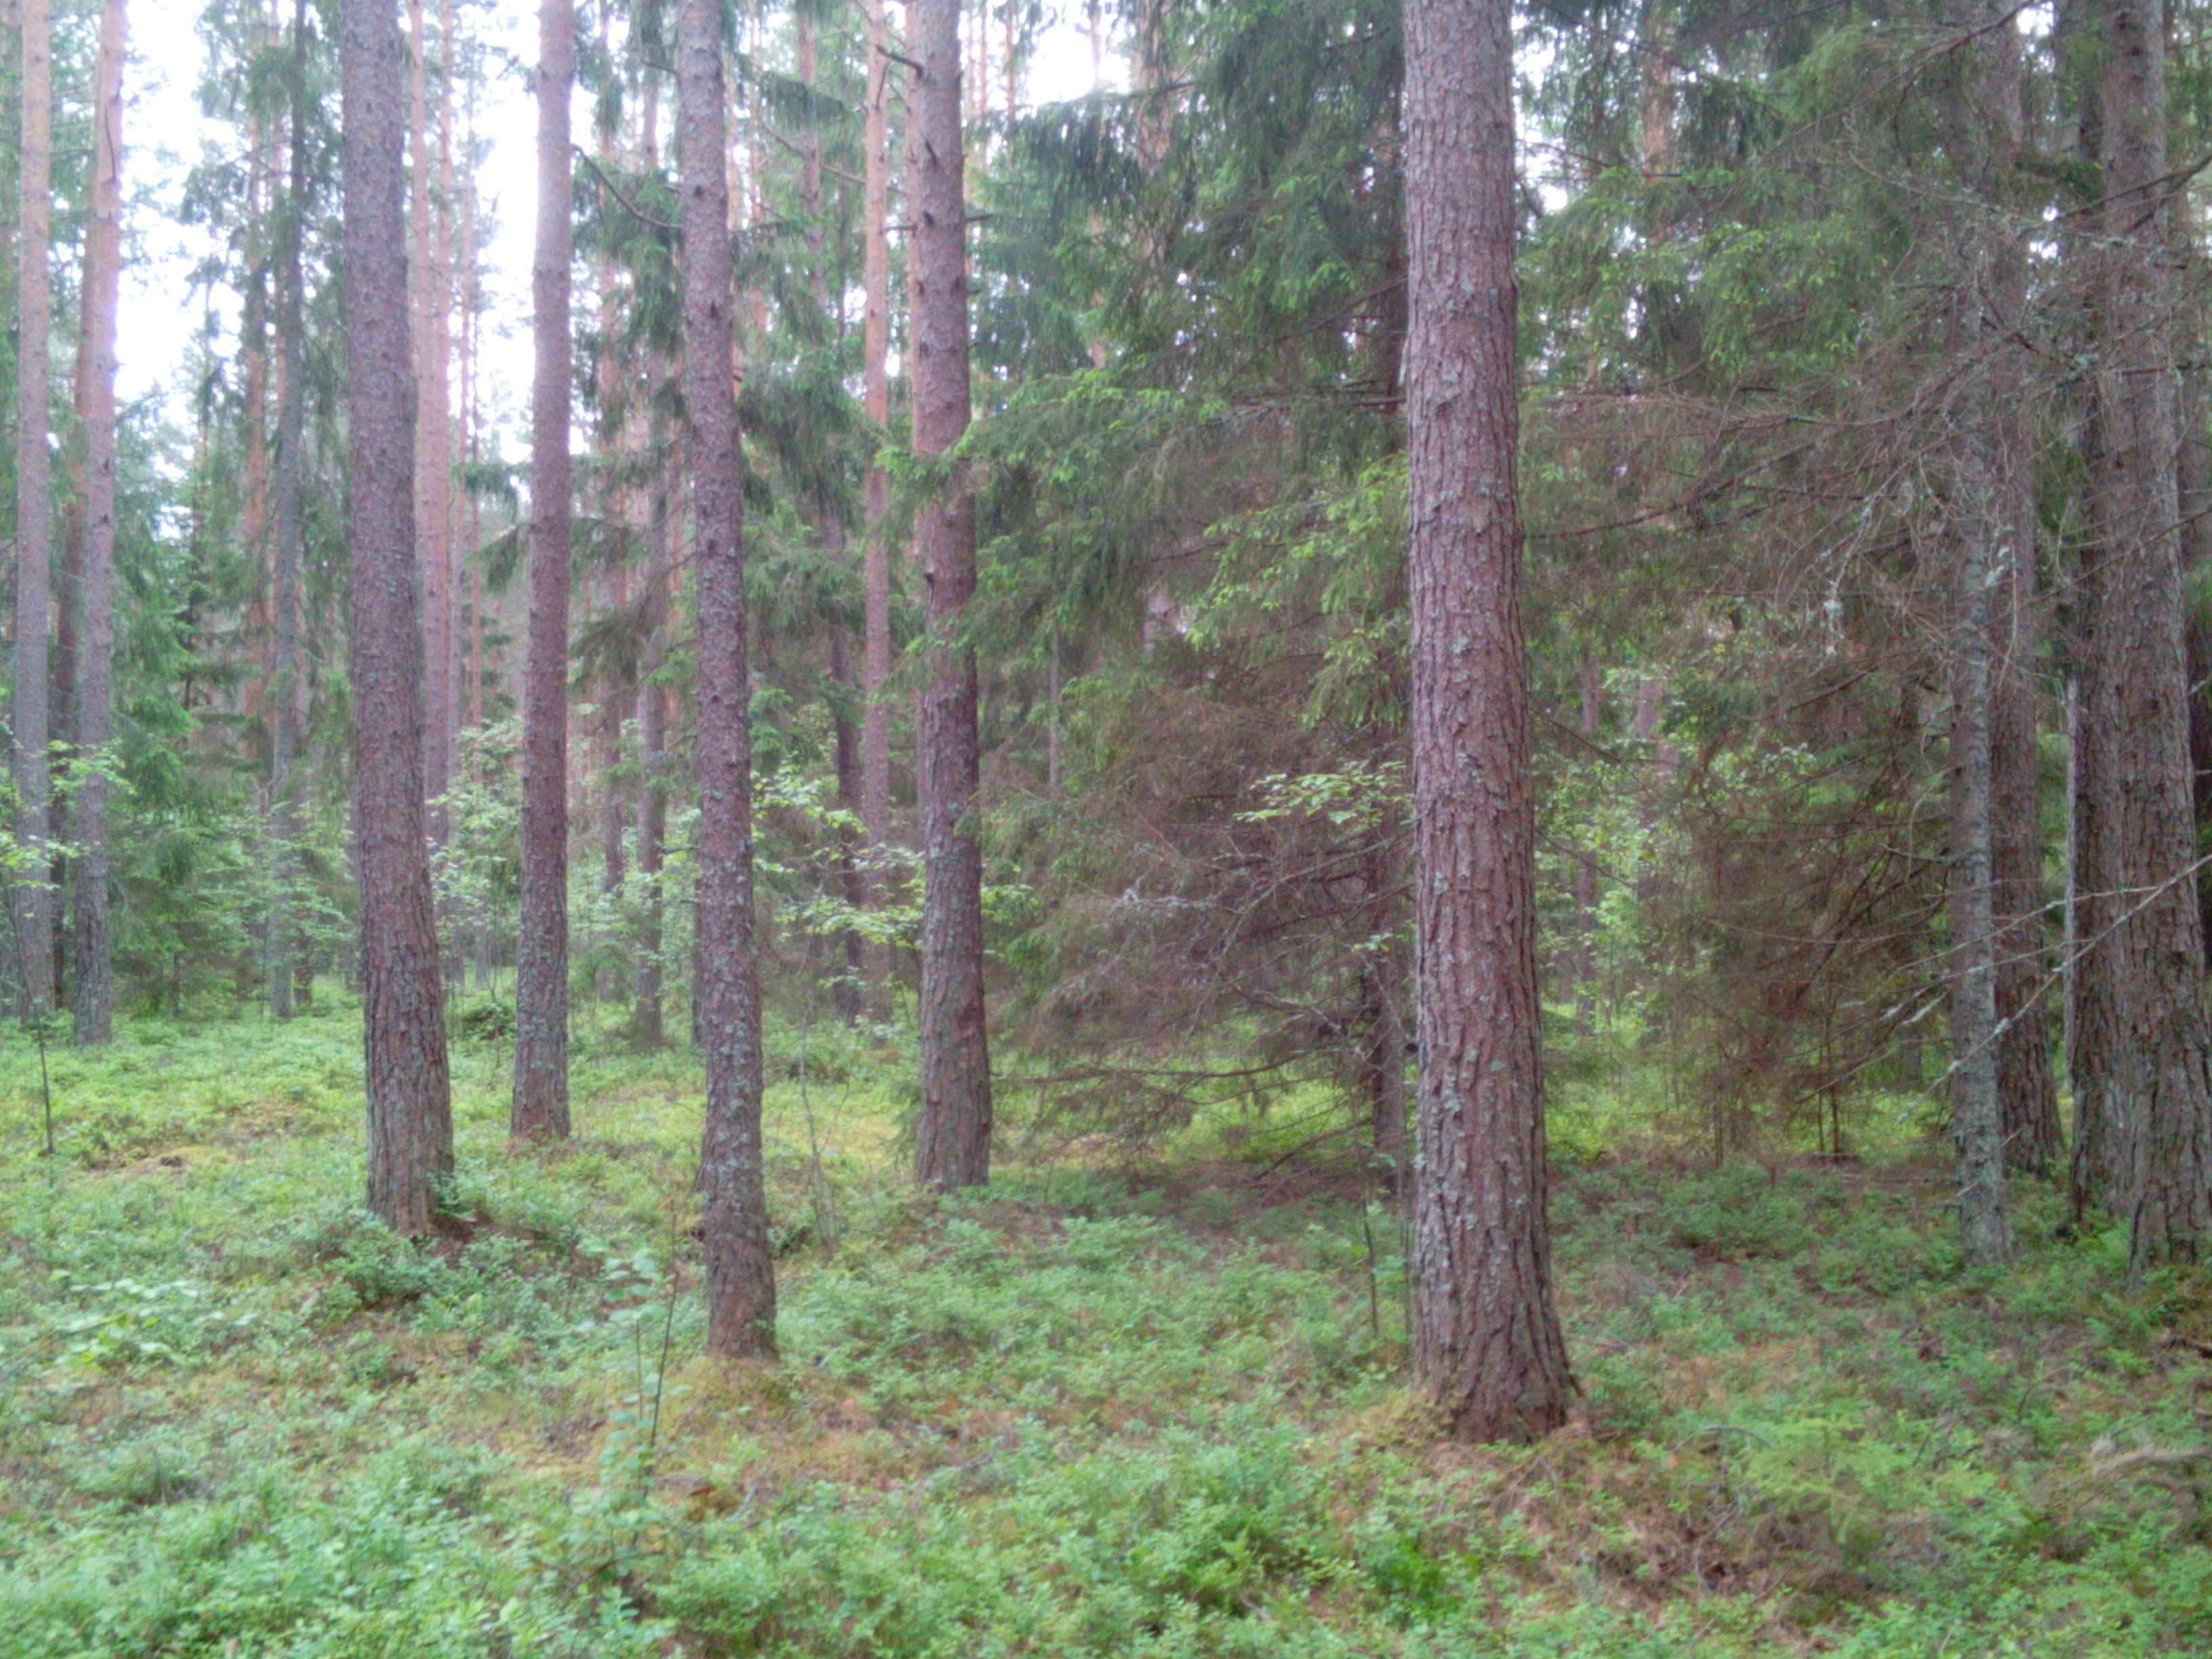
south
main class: Woodland
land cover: Other coniferous woodland
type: hemiboreal forest and nemoral coniferous forest and mixed broadleaved-coniferous forest
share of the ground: > 75 %
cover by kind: coniferous forest trees 80 %, herbaceous plants 10 %, lichens and mosses 10 %
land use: Forestry
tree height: > 5 m
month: June
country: LV
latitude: 56.9420
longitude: 21.4971
